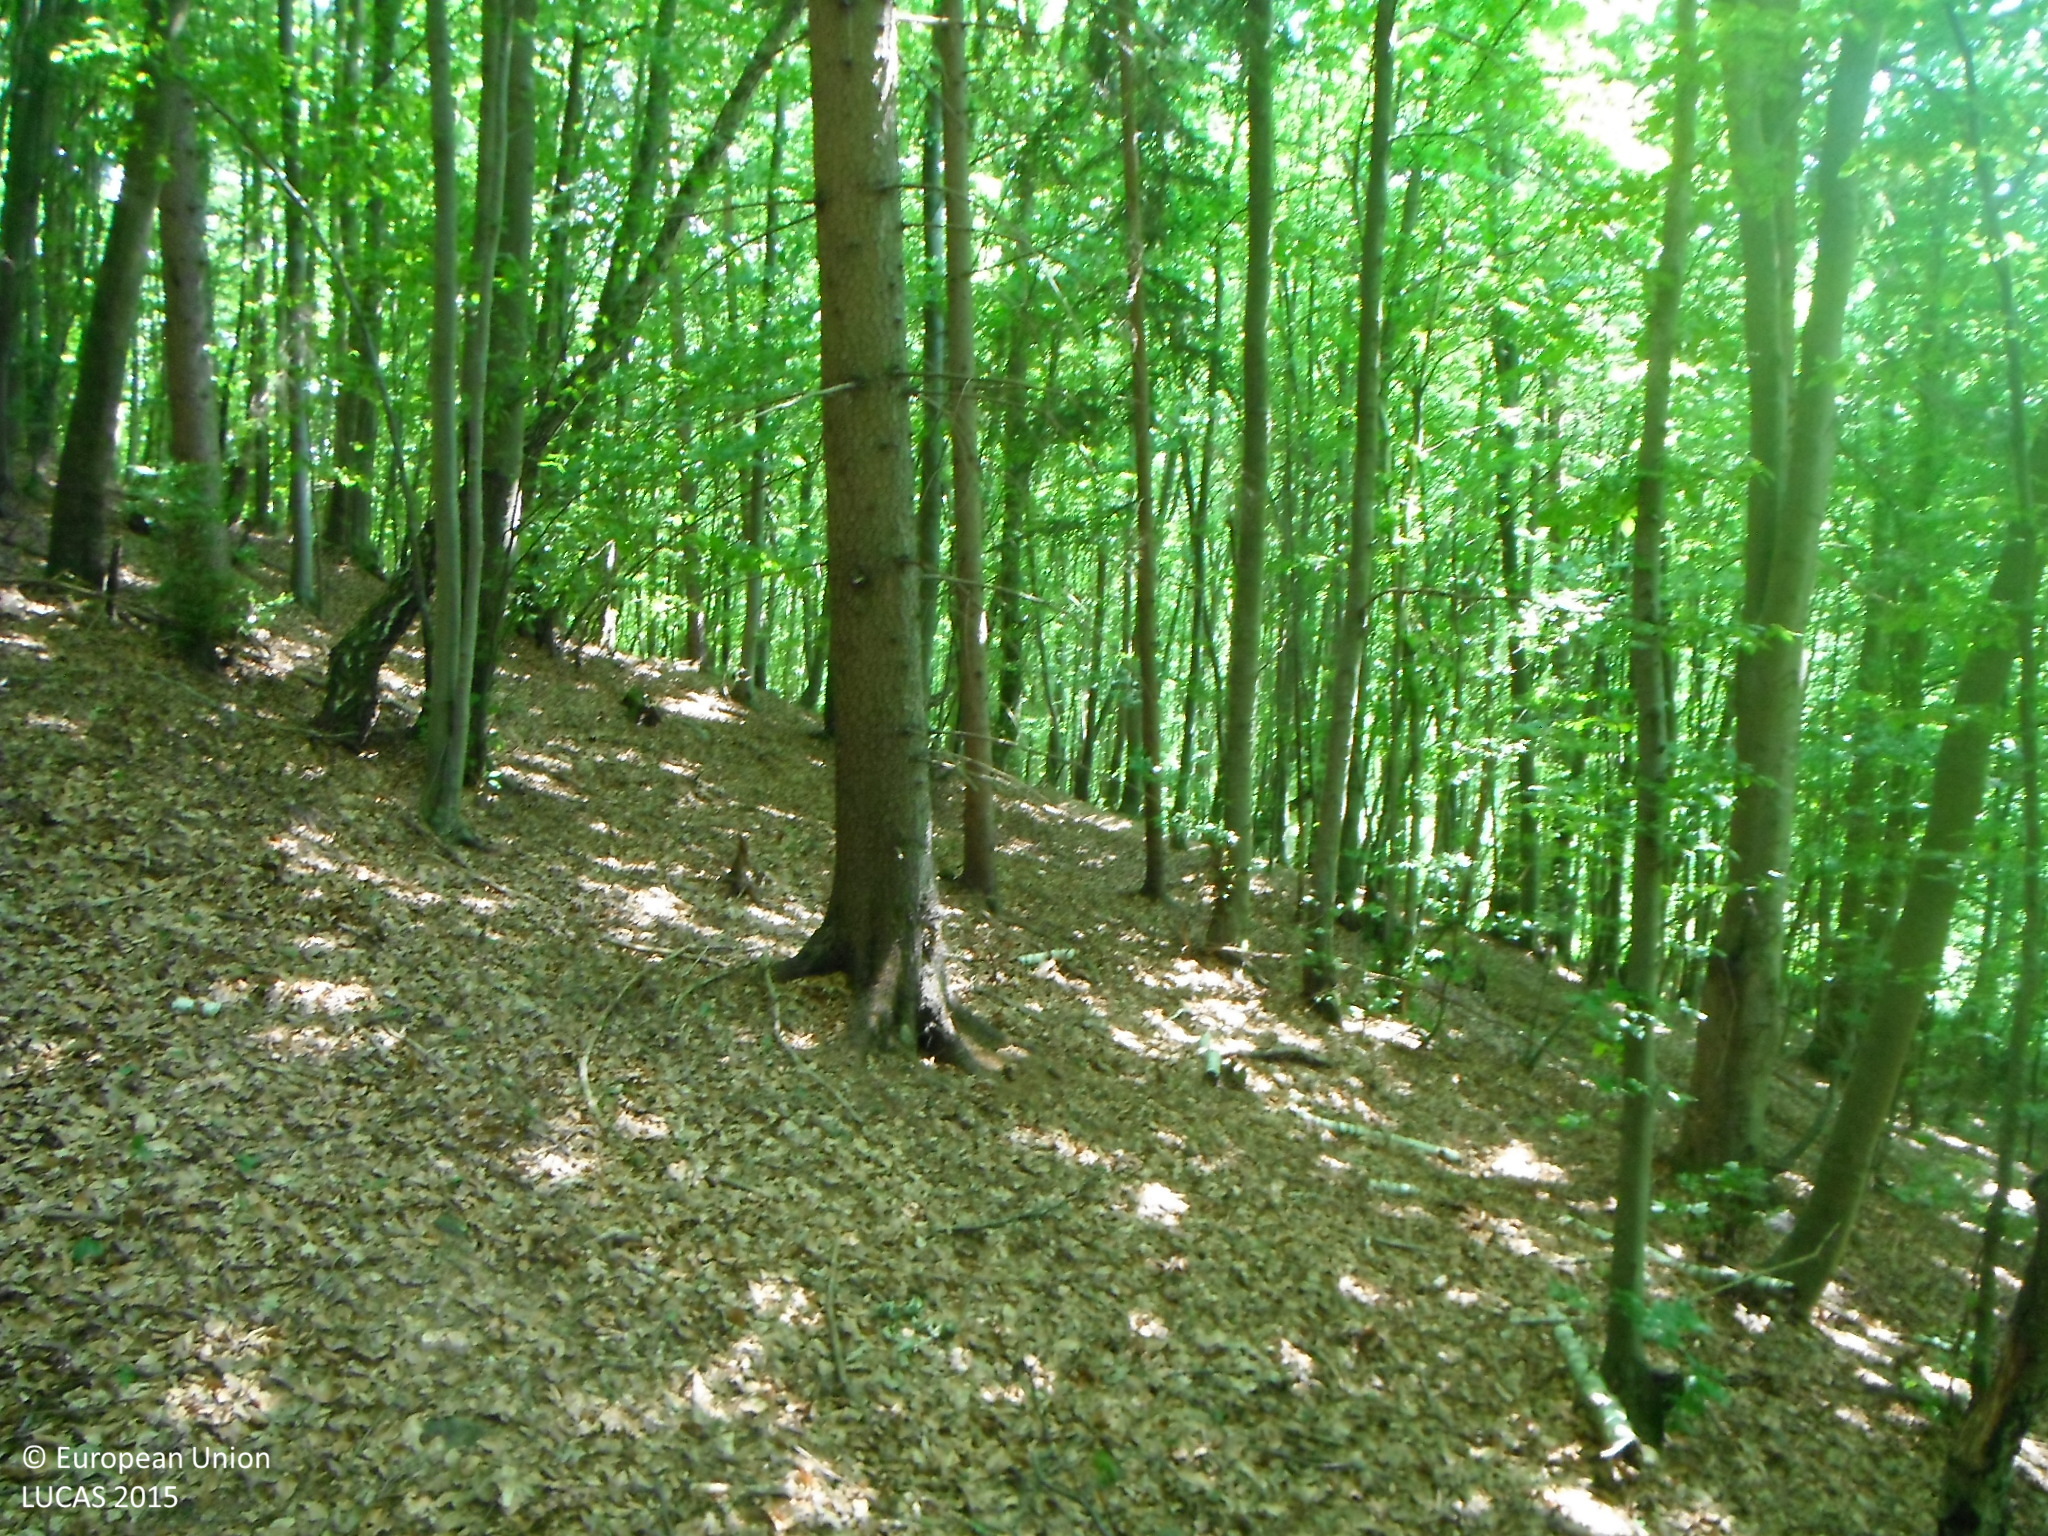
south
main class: Woodland
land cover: Spruce dominated mixed woodland
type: mountainous beech forest
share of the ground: > 75 %
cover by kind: broadleaved forest trees 70 %, coniferous forest trees 30 %
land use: Forestry
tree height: > 5 m
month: June
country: SK
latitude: 48.6808
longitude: 19.3001
